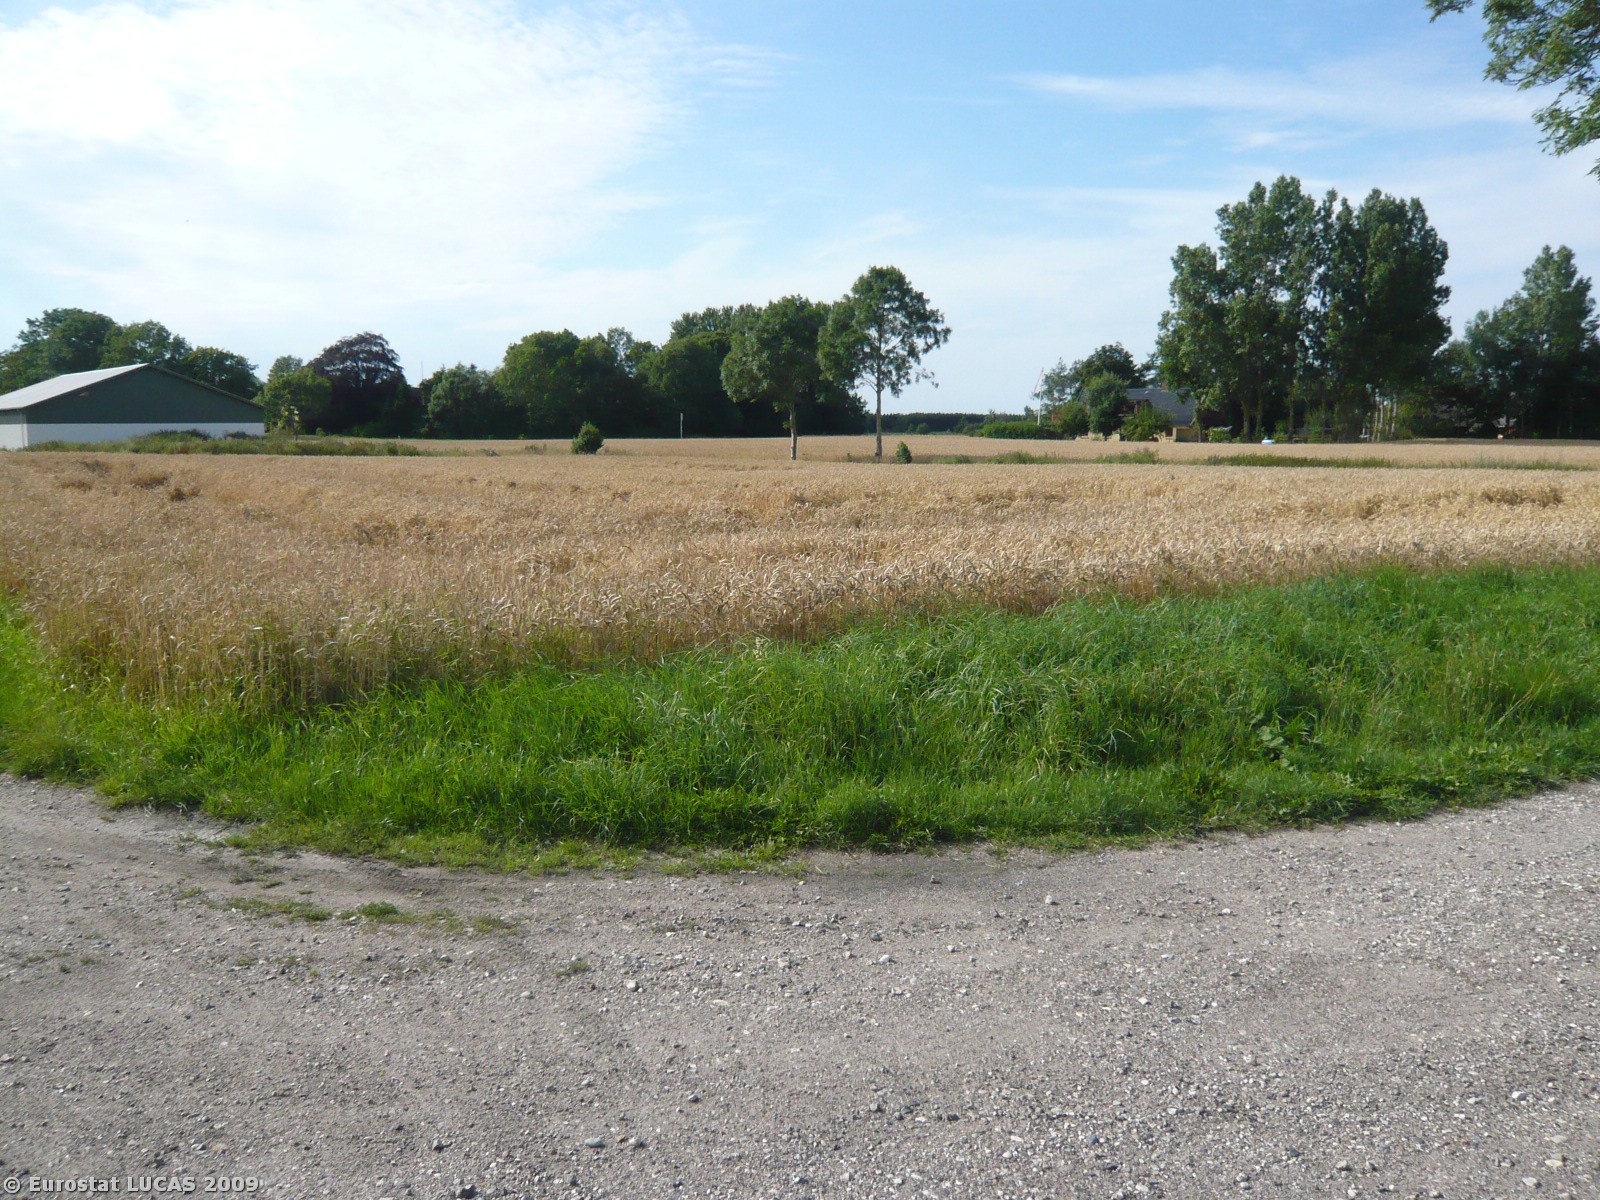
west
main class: Cropland
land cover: Common wheat
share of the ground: > 75 %
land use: Agriculture (excluding fallow land and kitchen gardens)
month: August
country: DK
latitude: 56.0953
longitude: 12.2964
